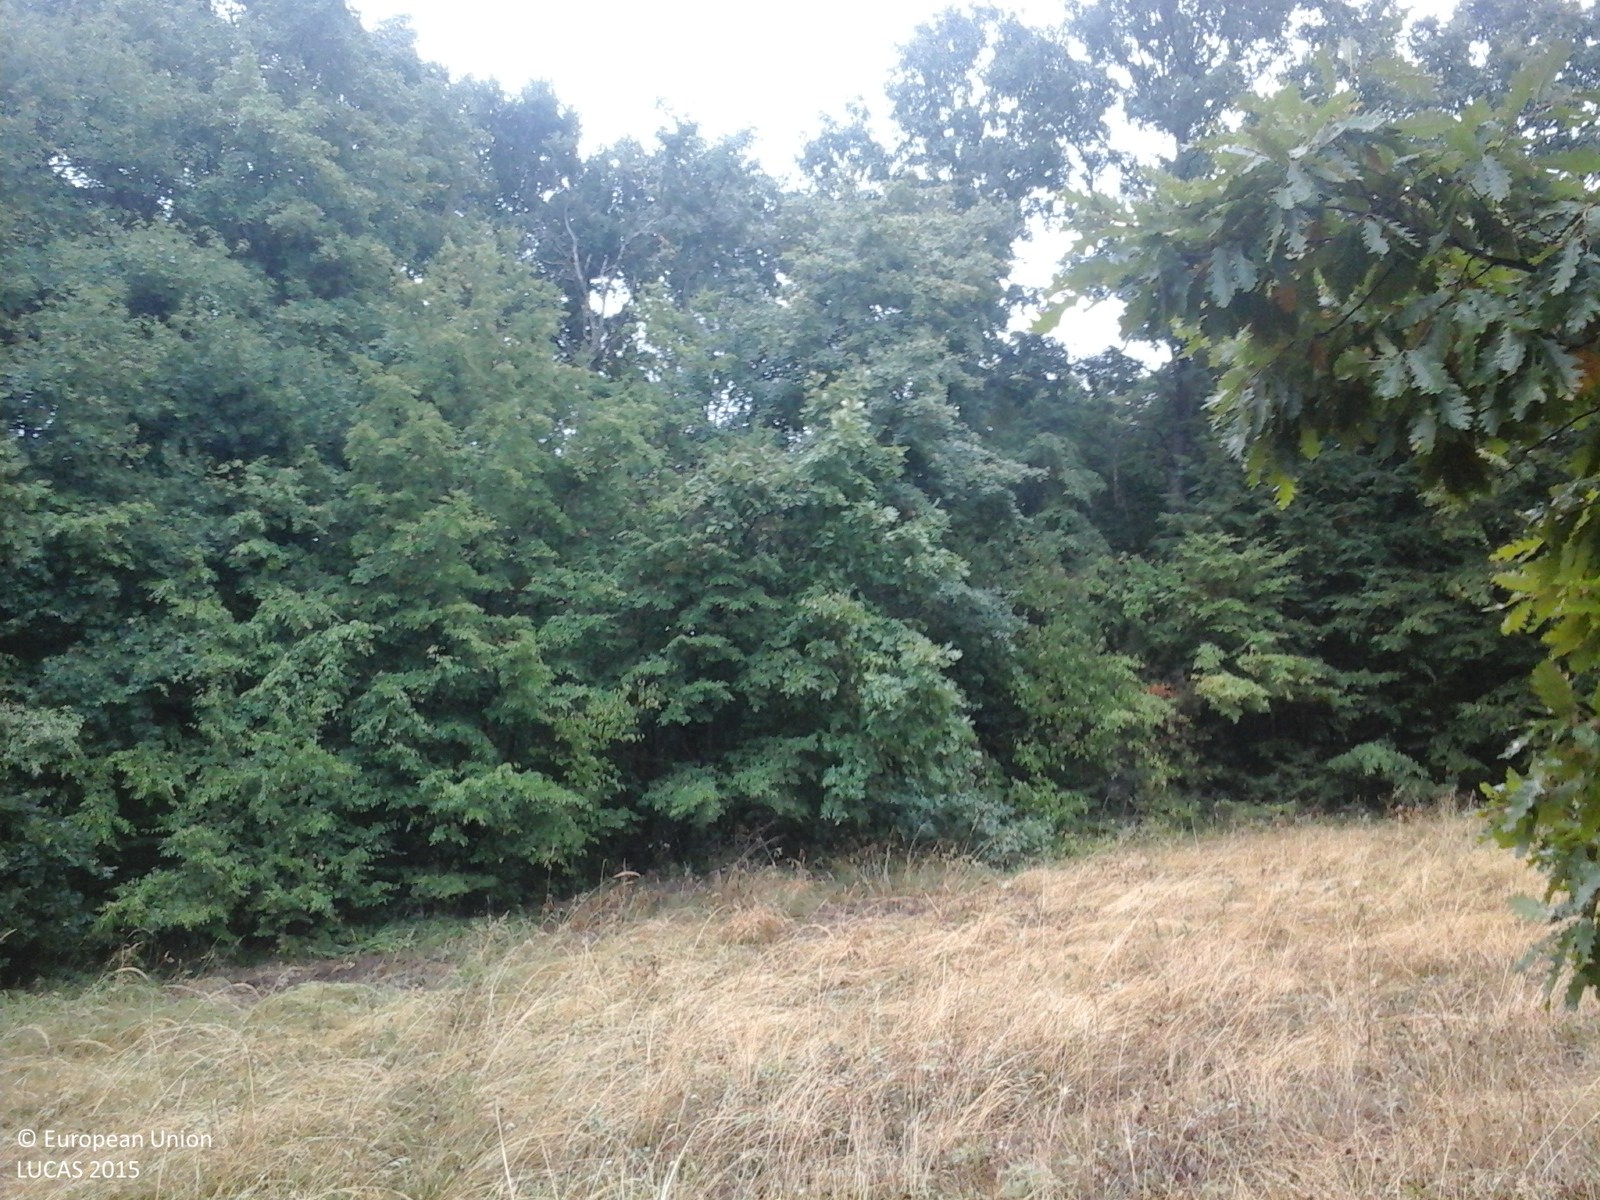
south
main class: Woodland
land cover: Broadleaved woodland
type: thermophilous deciduous forest
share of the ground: > 75 %
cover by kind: broadleaved forest trees 100 %
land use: Forestry
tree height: > 5 m
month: August
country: RO
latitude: 44.5145
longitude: 22.0974
